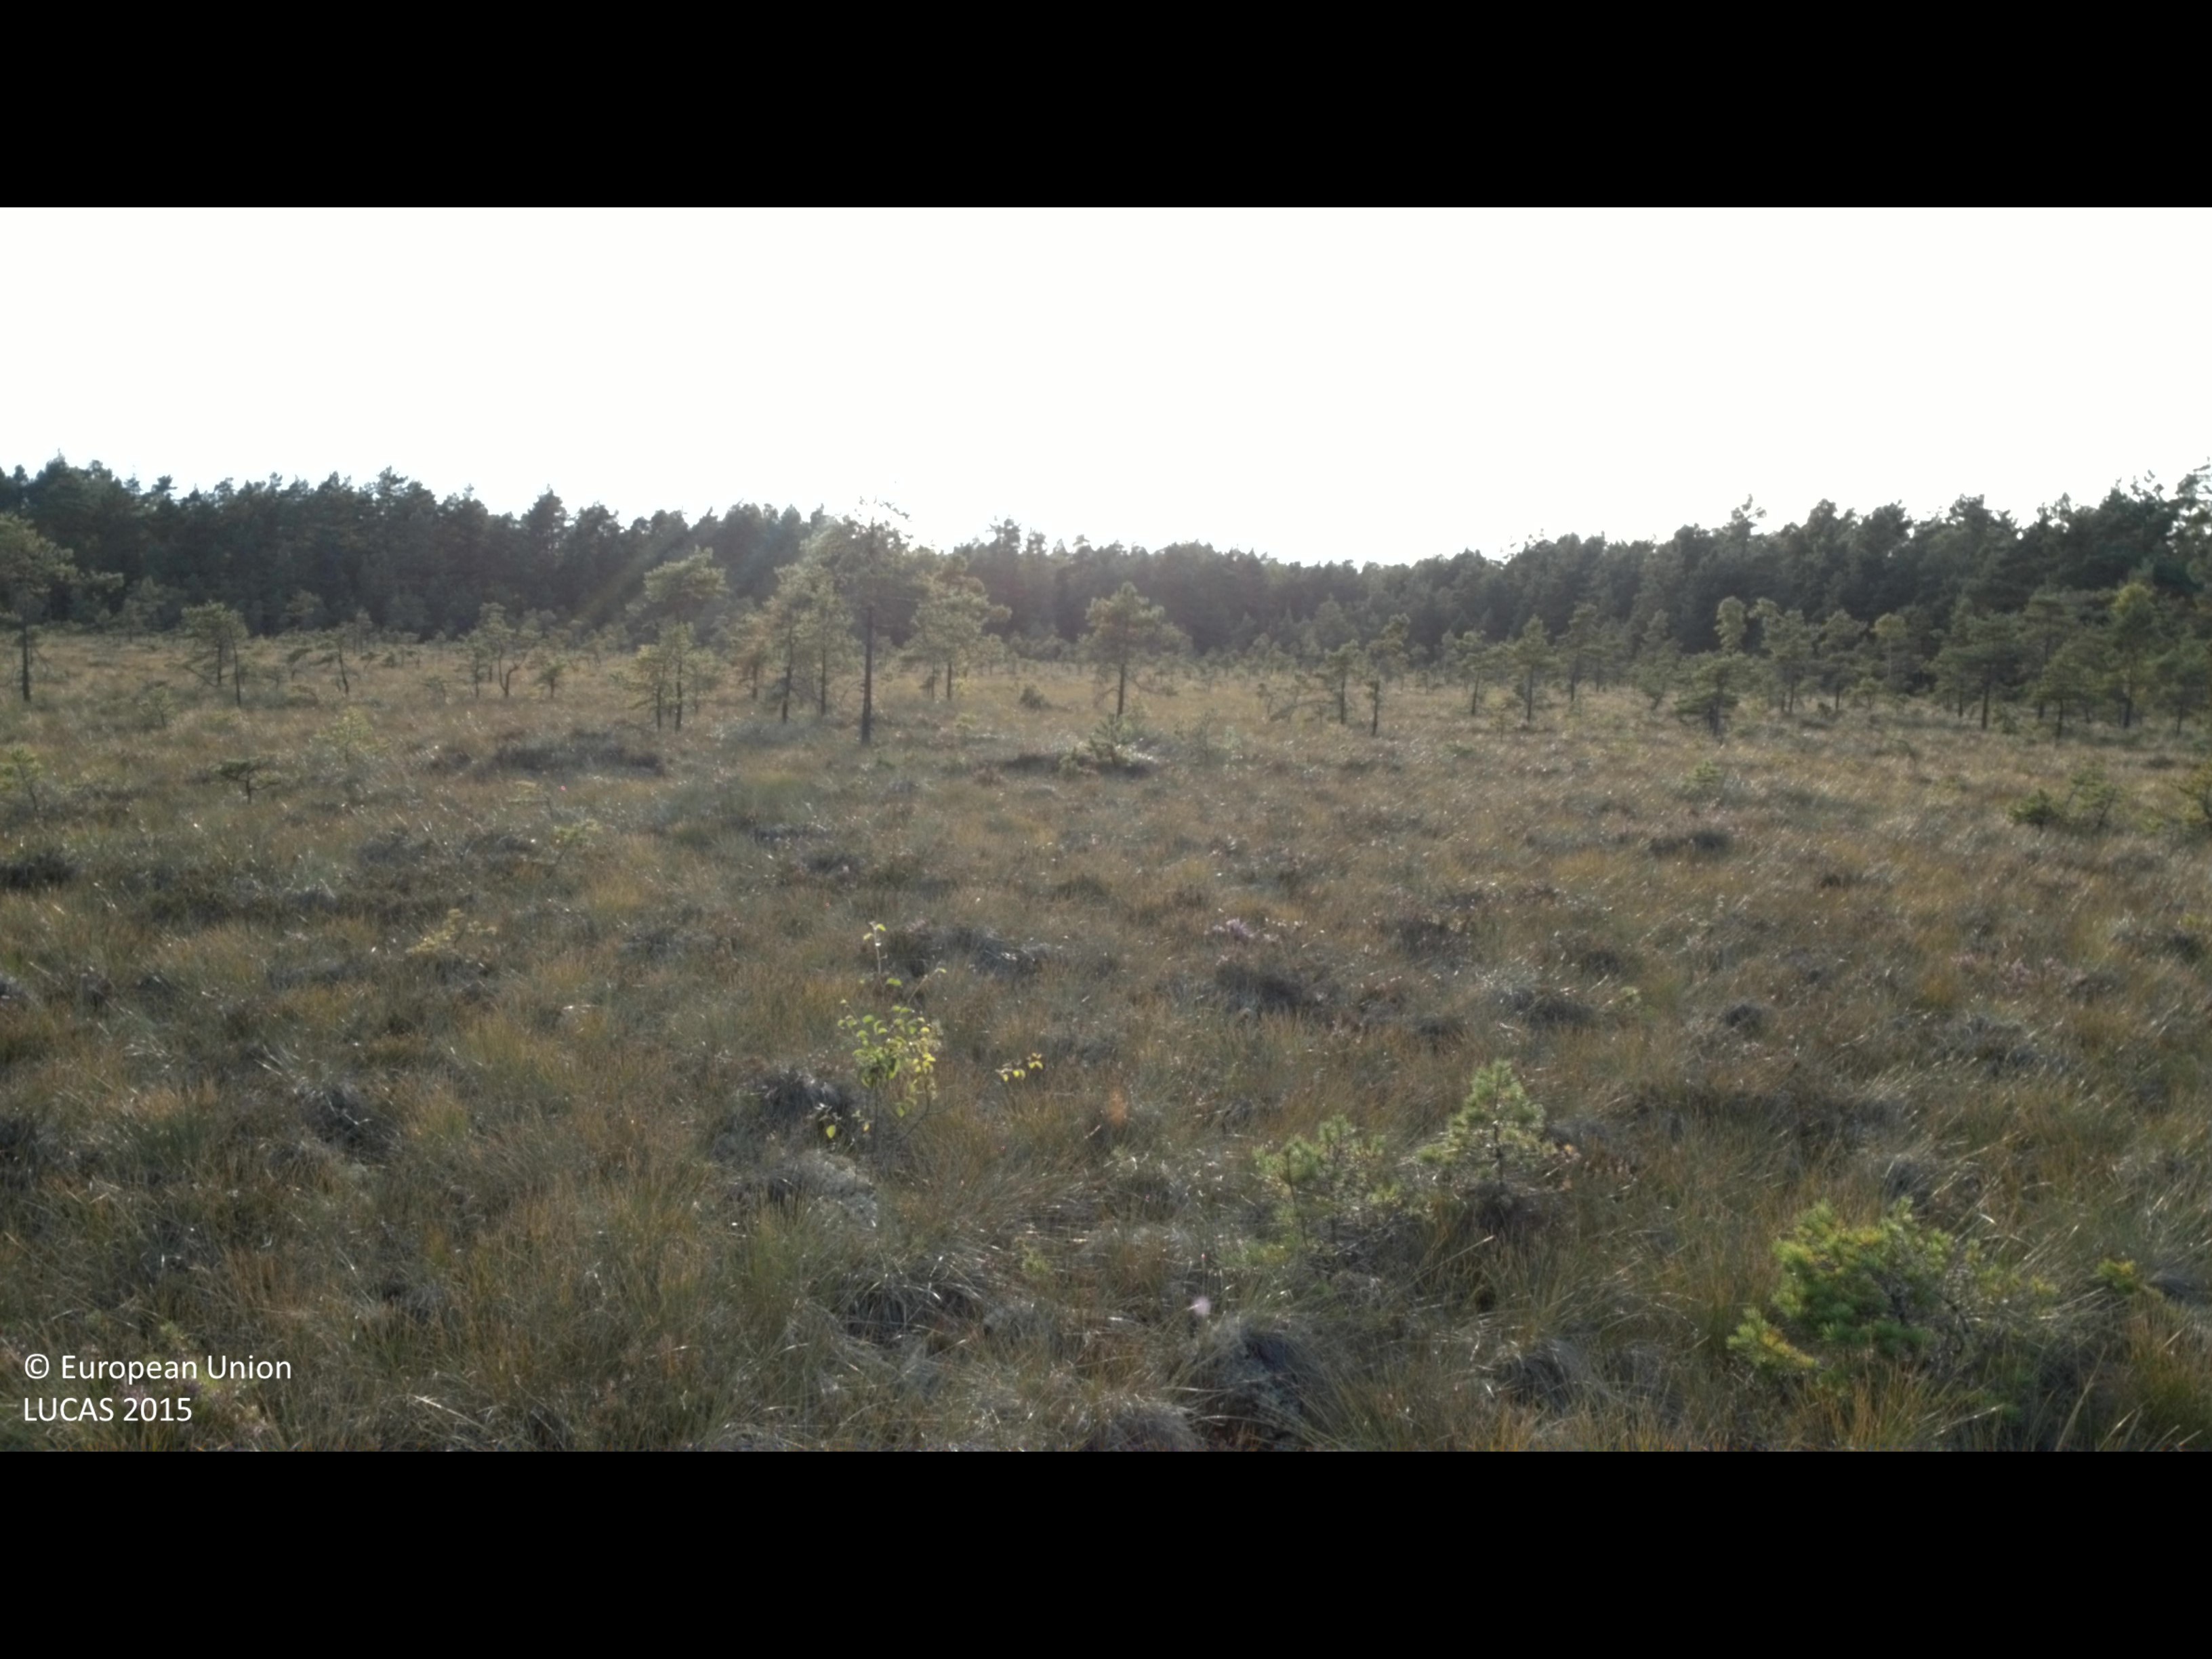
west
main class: Woodland
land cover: Pine dominated coniferous woodland
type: mire and swamp forests
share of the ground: 10 - 25 %
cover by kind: herbaceous plants 55 %, shrubs 20 %, coniferous forest trees 15 %, lichens and mosses 10 %
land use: Semi-natural and natural areas not in use
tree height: < 5 m
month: August
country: SE
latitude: 56.8969
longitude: 14.0845
